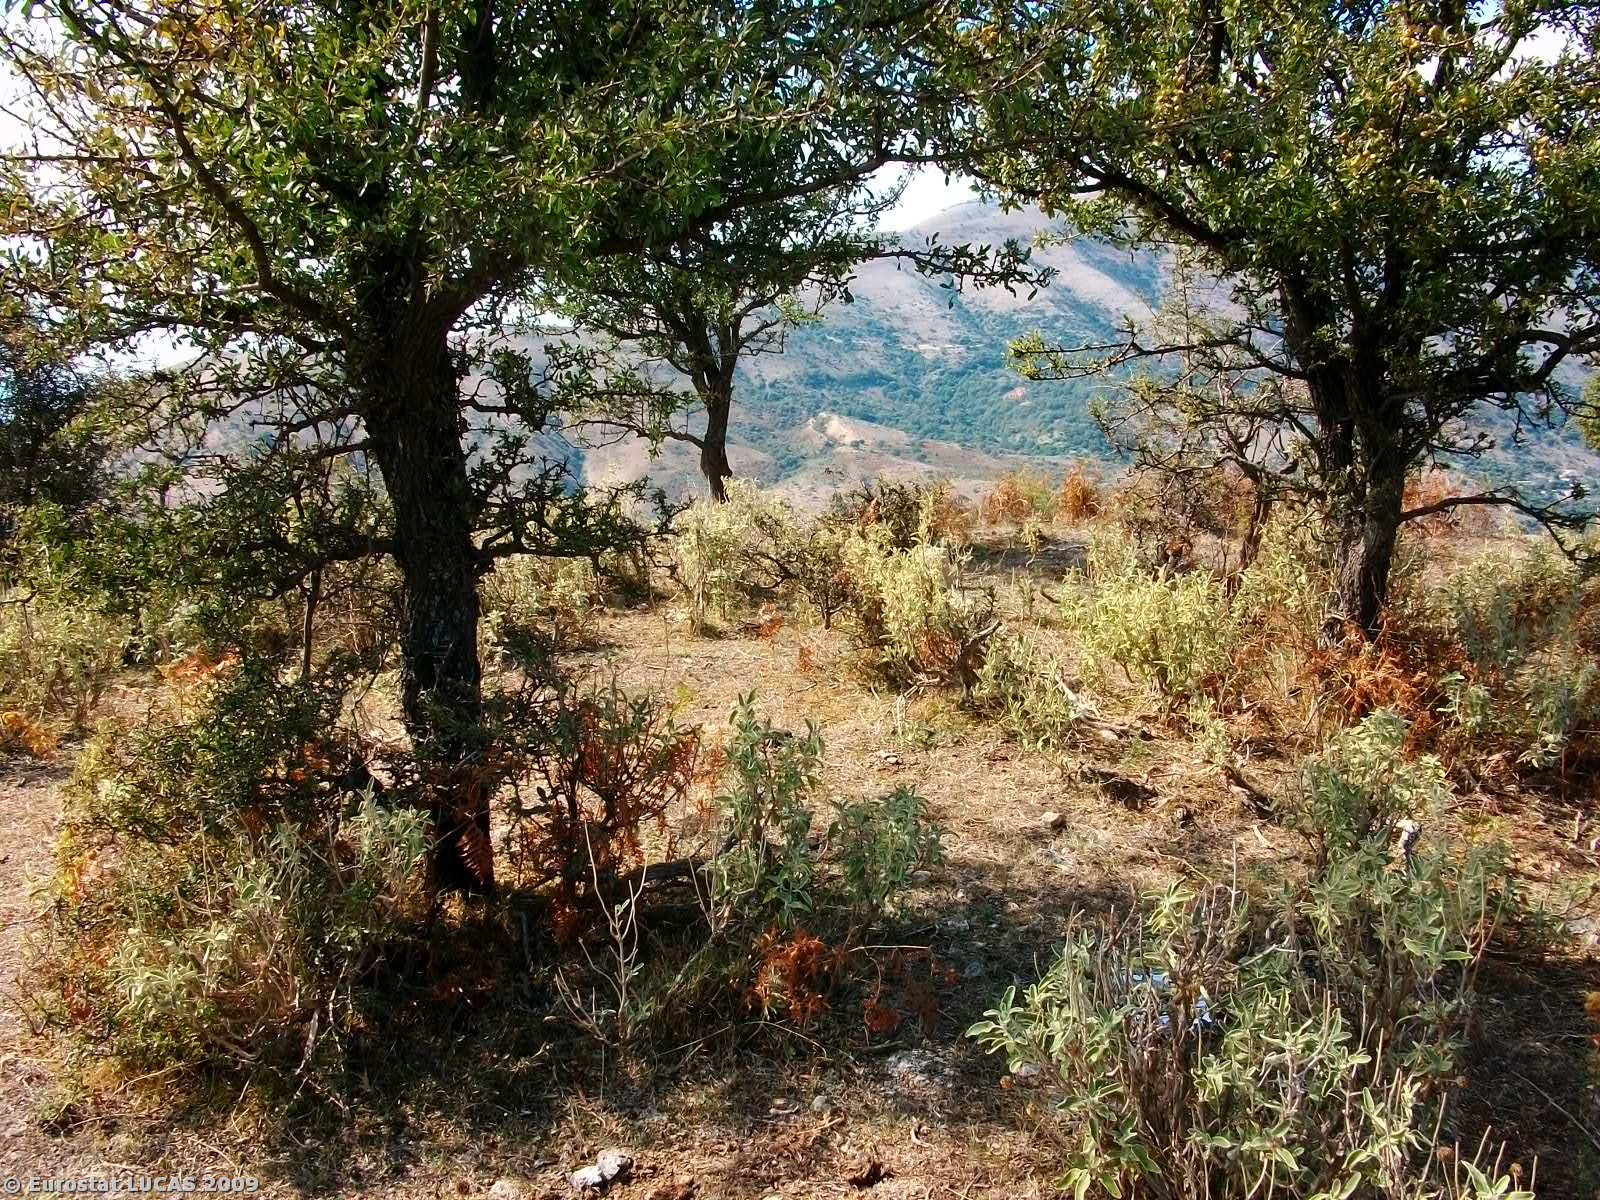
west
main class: Grassland
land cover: Grassland with sparse tree/shrub cover
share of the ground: > 75 %
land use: Agriculture (excluding fallow land and kitchen gardens)
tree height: < 5 m
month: September
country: GR
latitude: 39.6365
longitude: 20.2637
